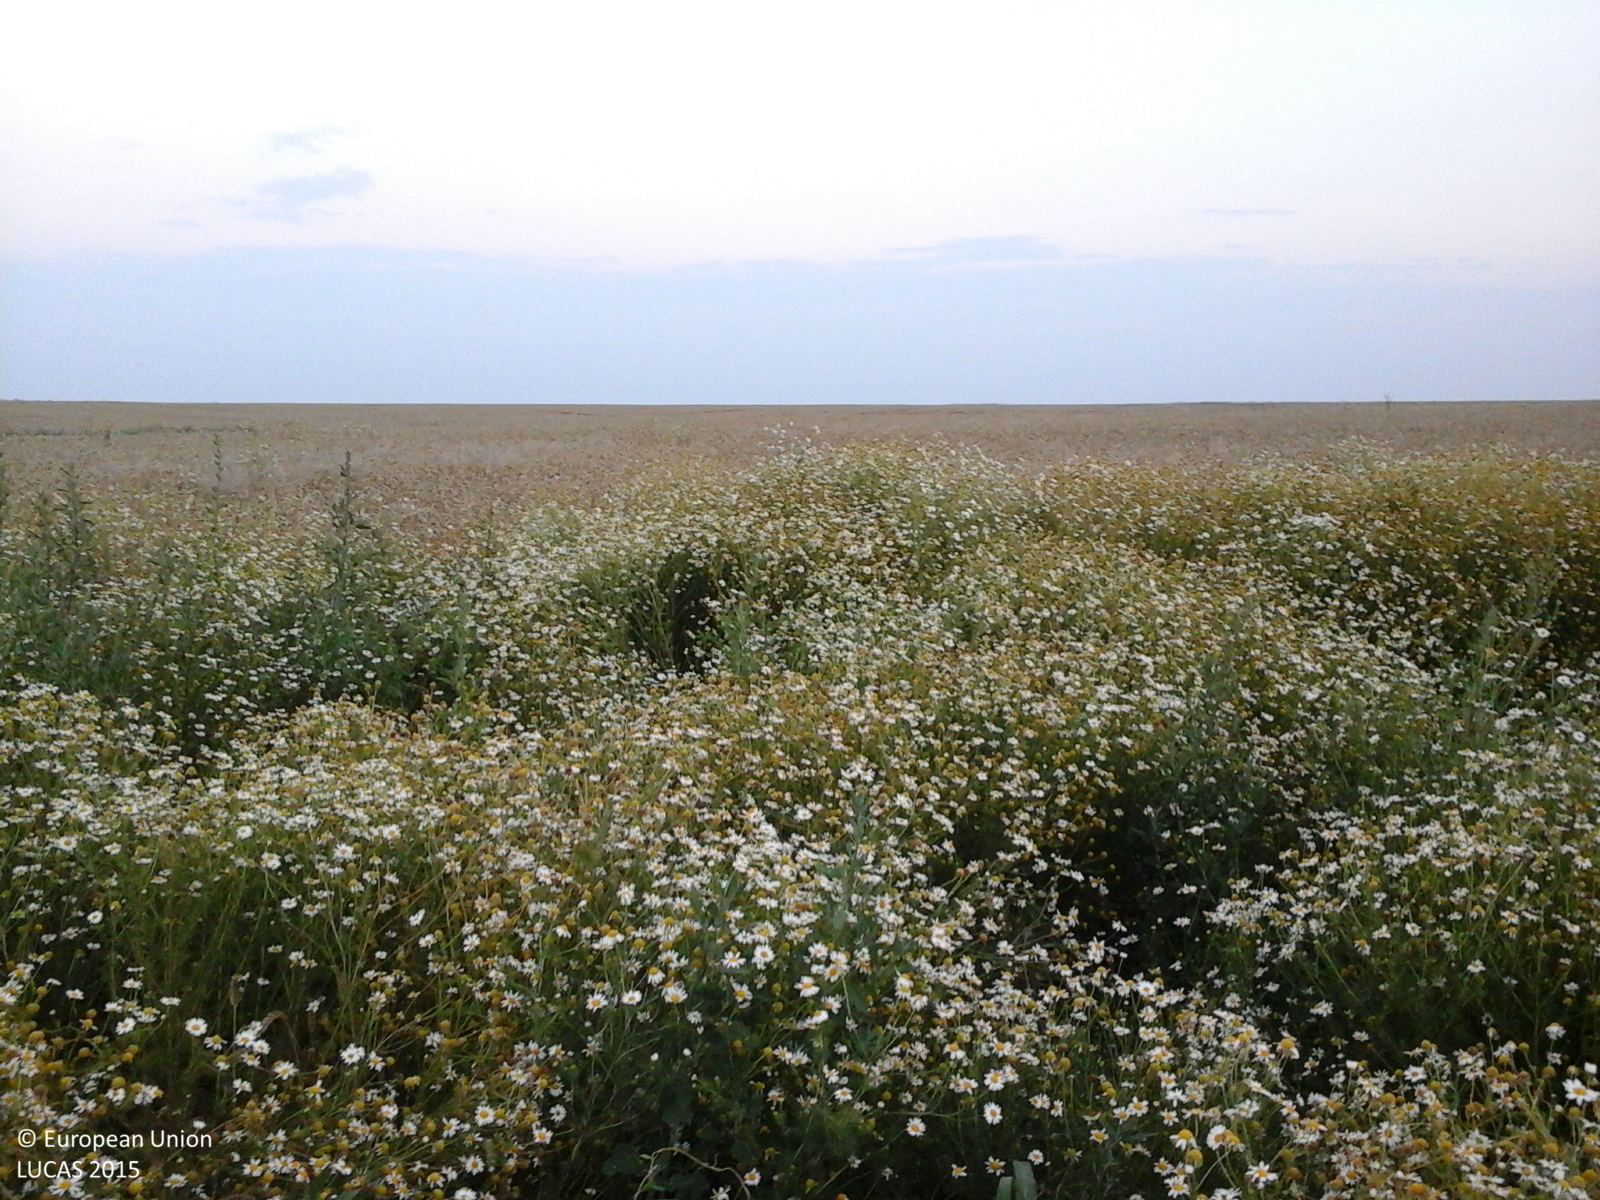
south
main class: Cropland
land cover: Other non-permanent industrial crops
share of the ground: > 75 %
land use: Agriculture (excluding fallow land and kitchen gardens)
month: July
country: RO
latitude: 43.7799
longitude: 25.2756
